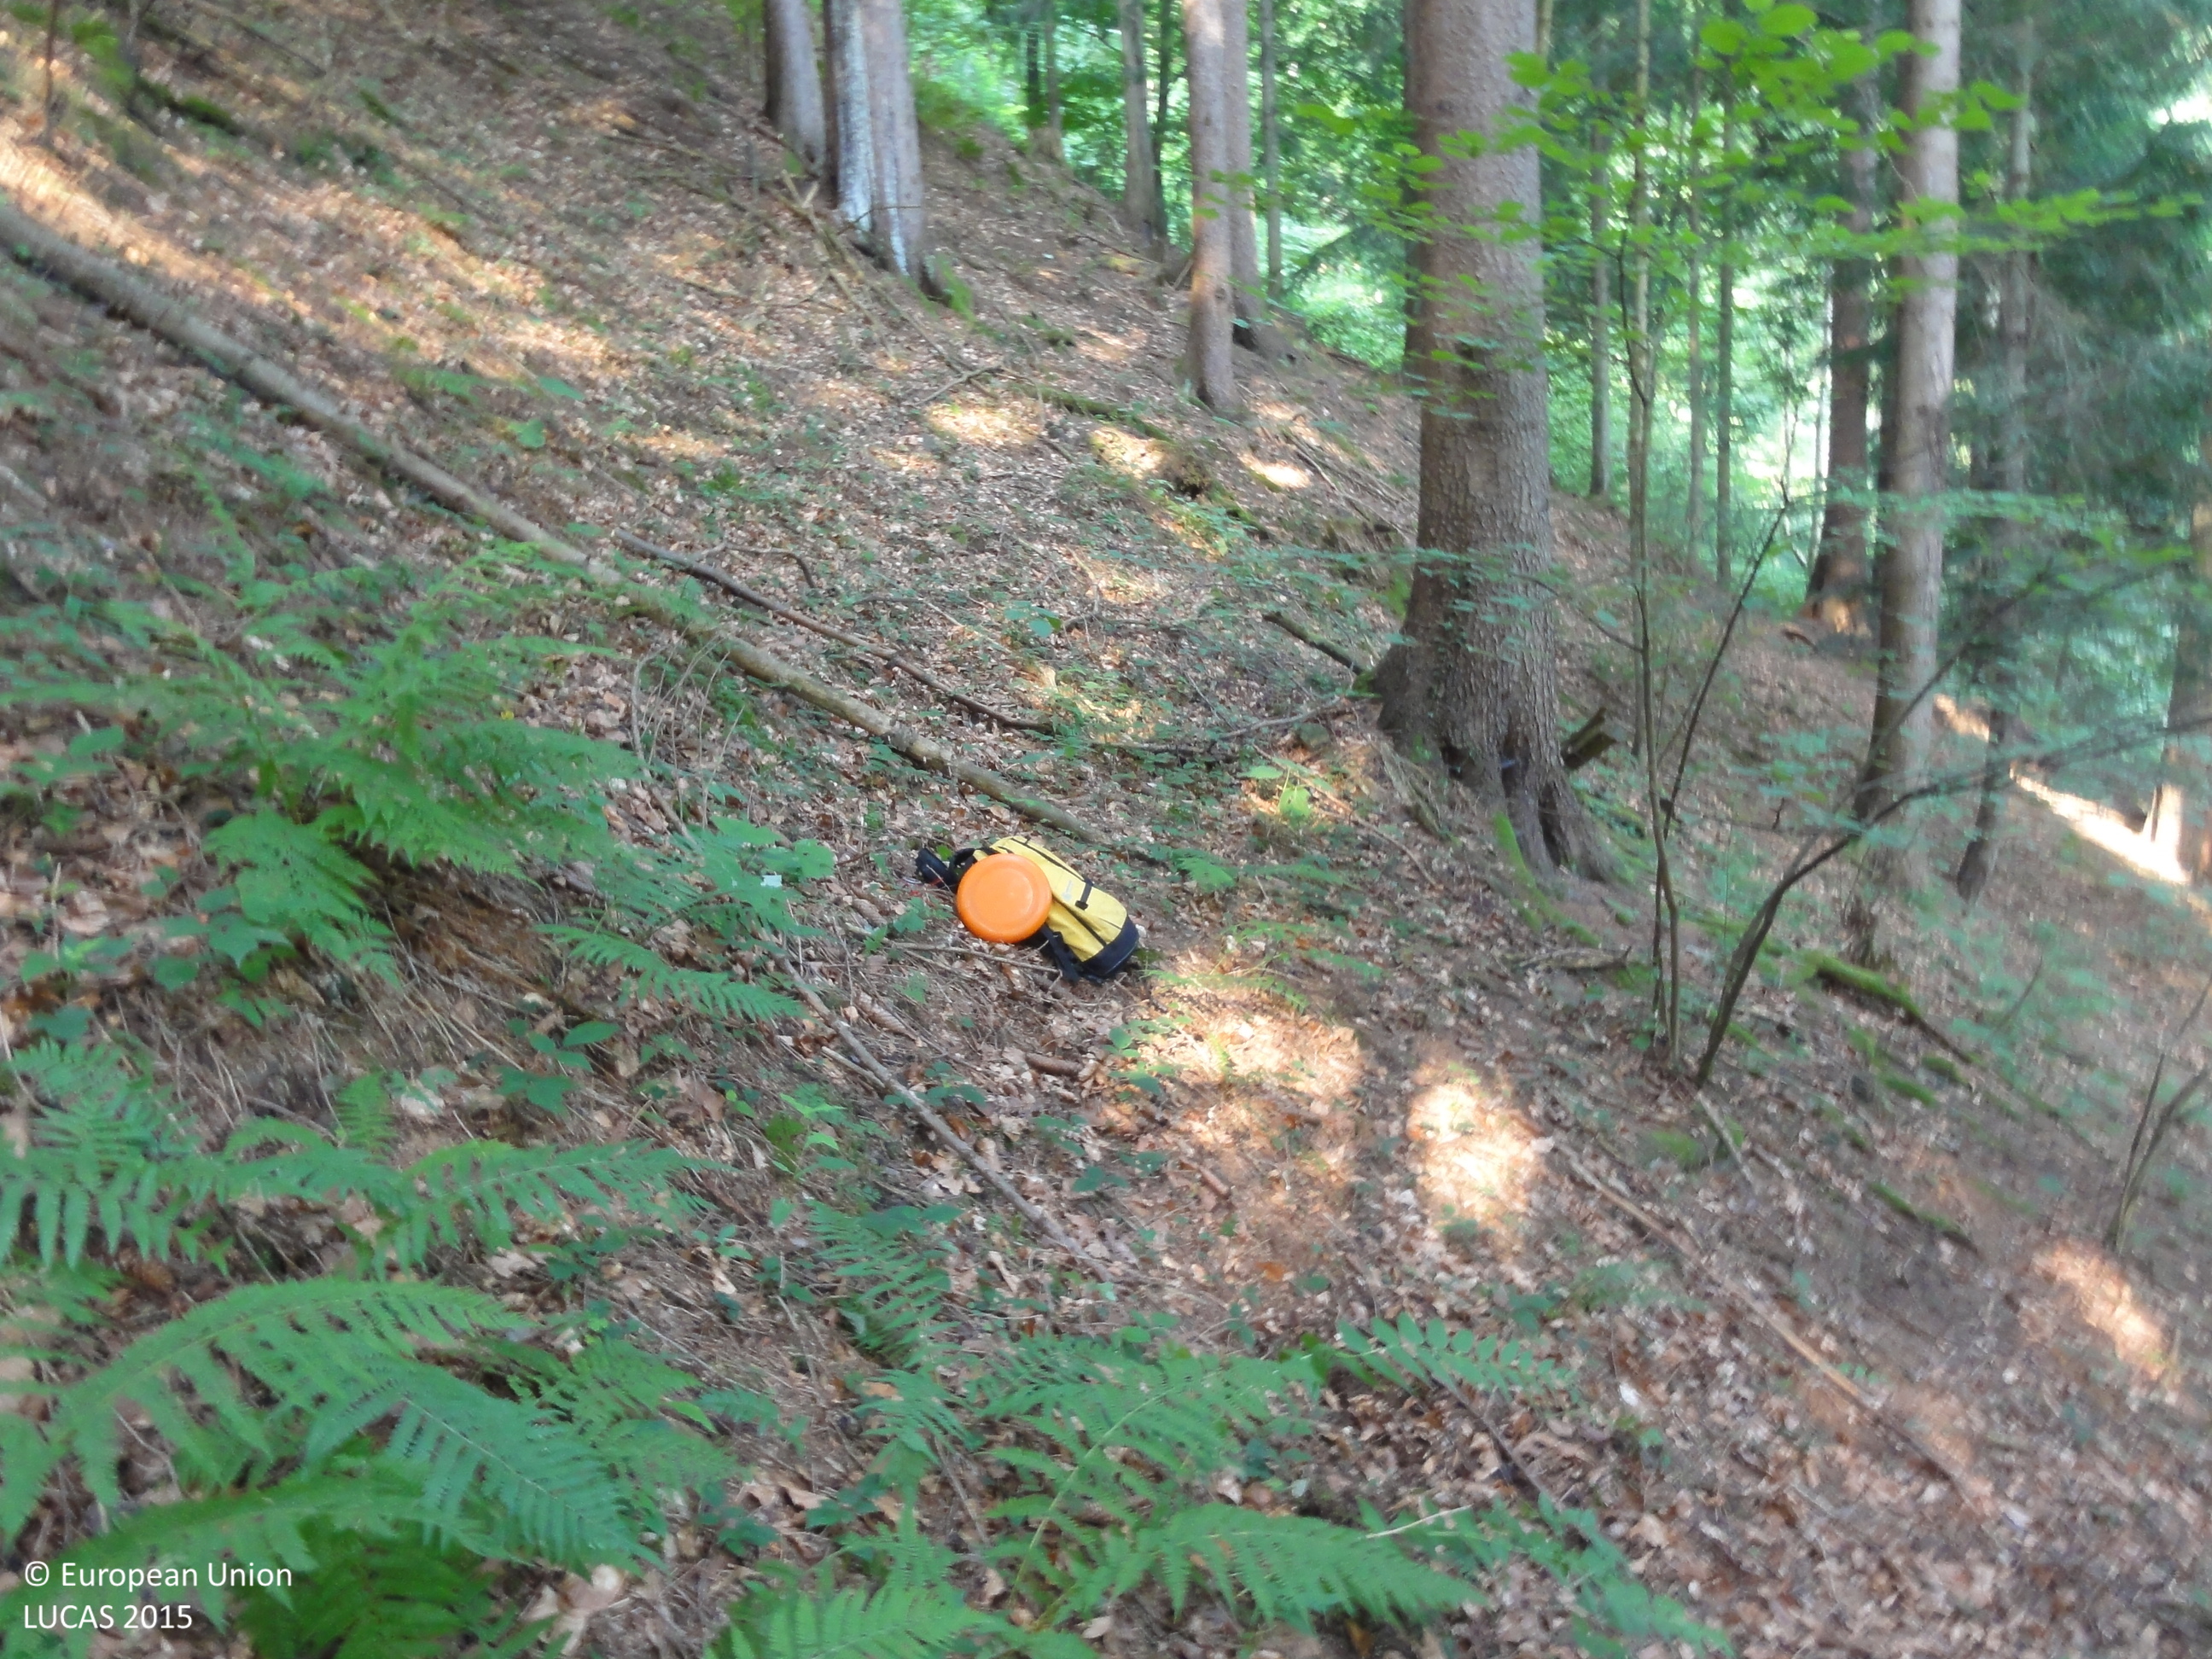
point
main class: Woodland
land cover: Spruce dominated mixed woodland
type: mountainous beech forest
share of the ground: > 75 %
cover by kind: coniferous forest trees 65 %, broadleaved forest trees 35 %
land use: Forestry
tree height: > 5 m
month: July
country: SI
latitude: 46.5532
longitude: 15.1241
